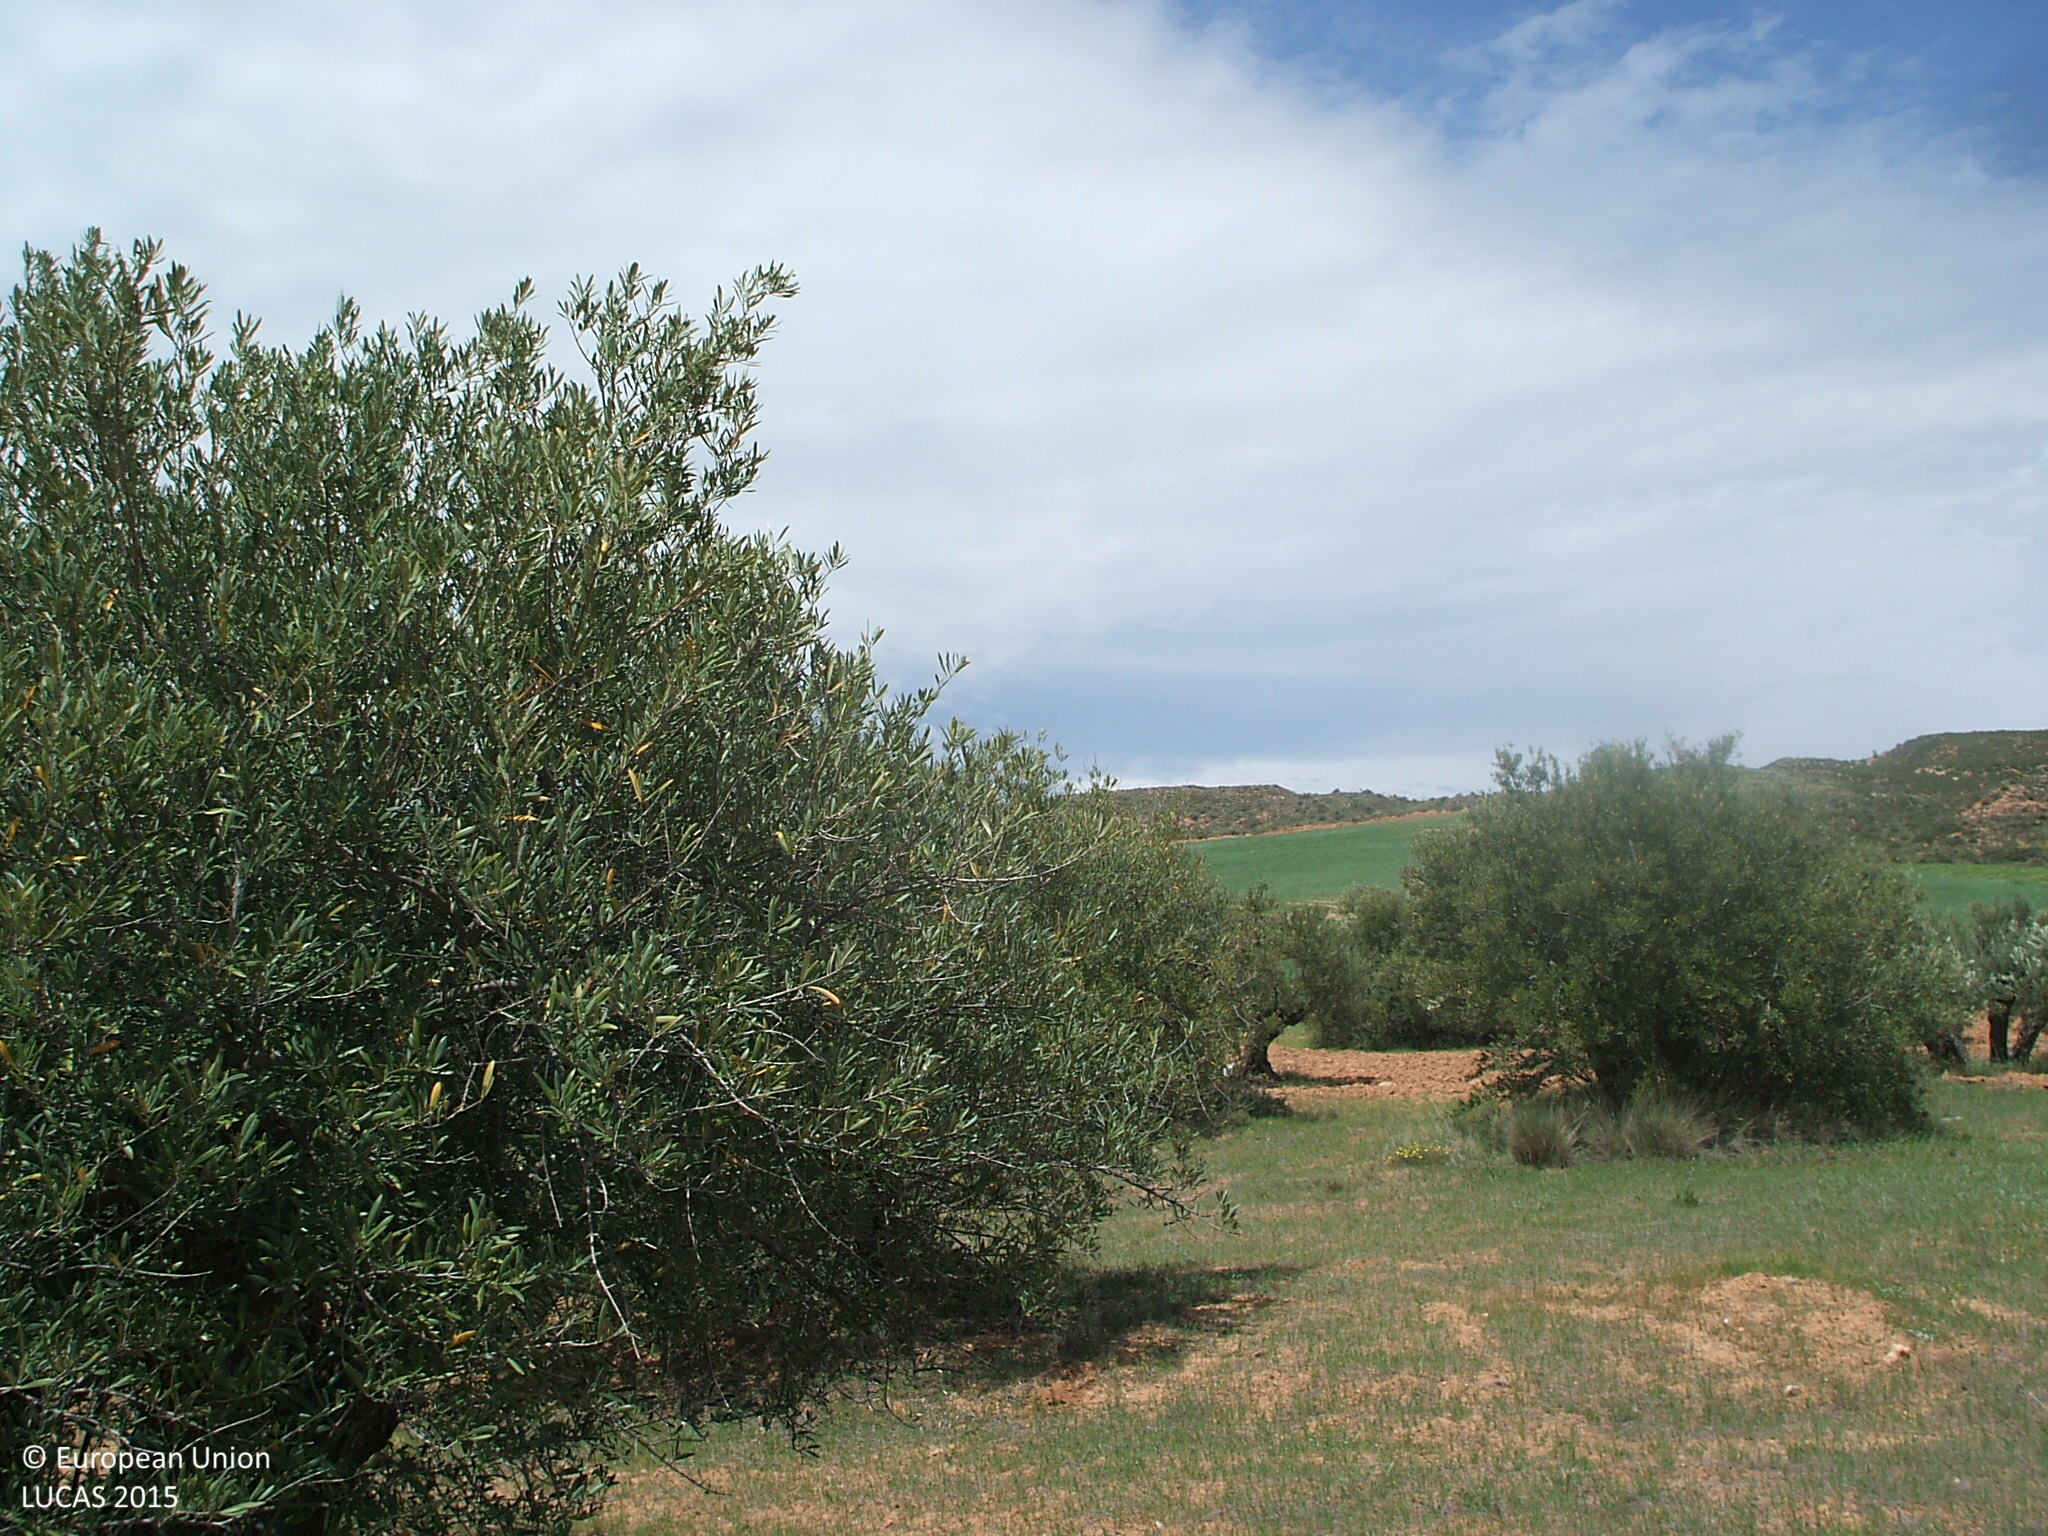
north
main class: Cropland
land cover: Olive groves
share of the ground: 25 - 50 %
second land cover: Grassland without tree/shrub cover
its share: > 75 %
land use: Agriculture (excluding fallow land and kitchen gardens)
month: May
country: ES
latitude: 40.8230
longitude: -3.0171
